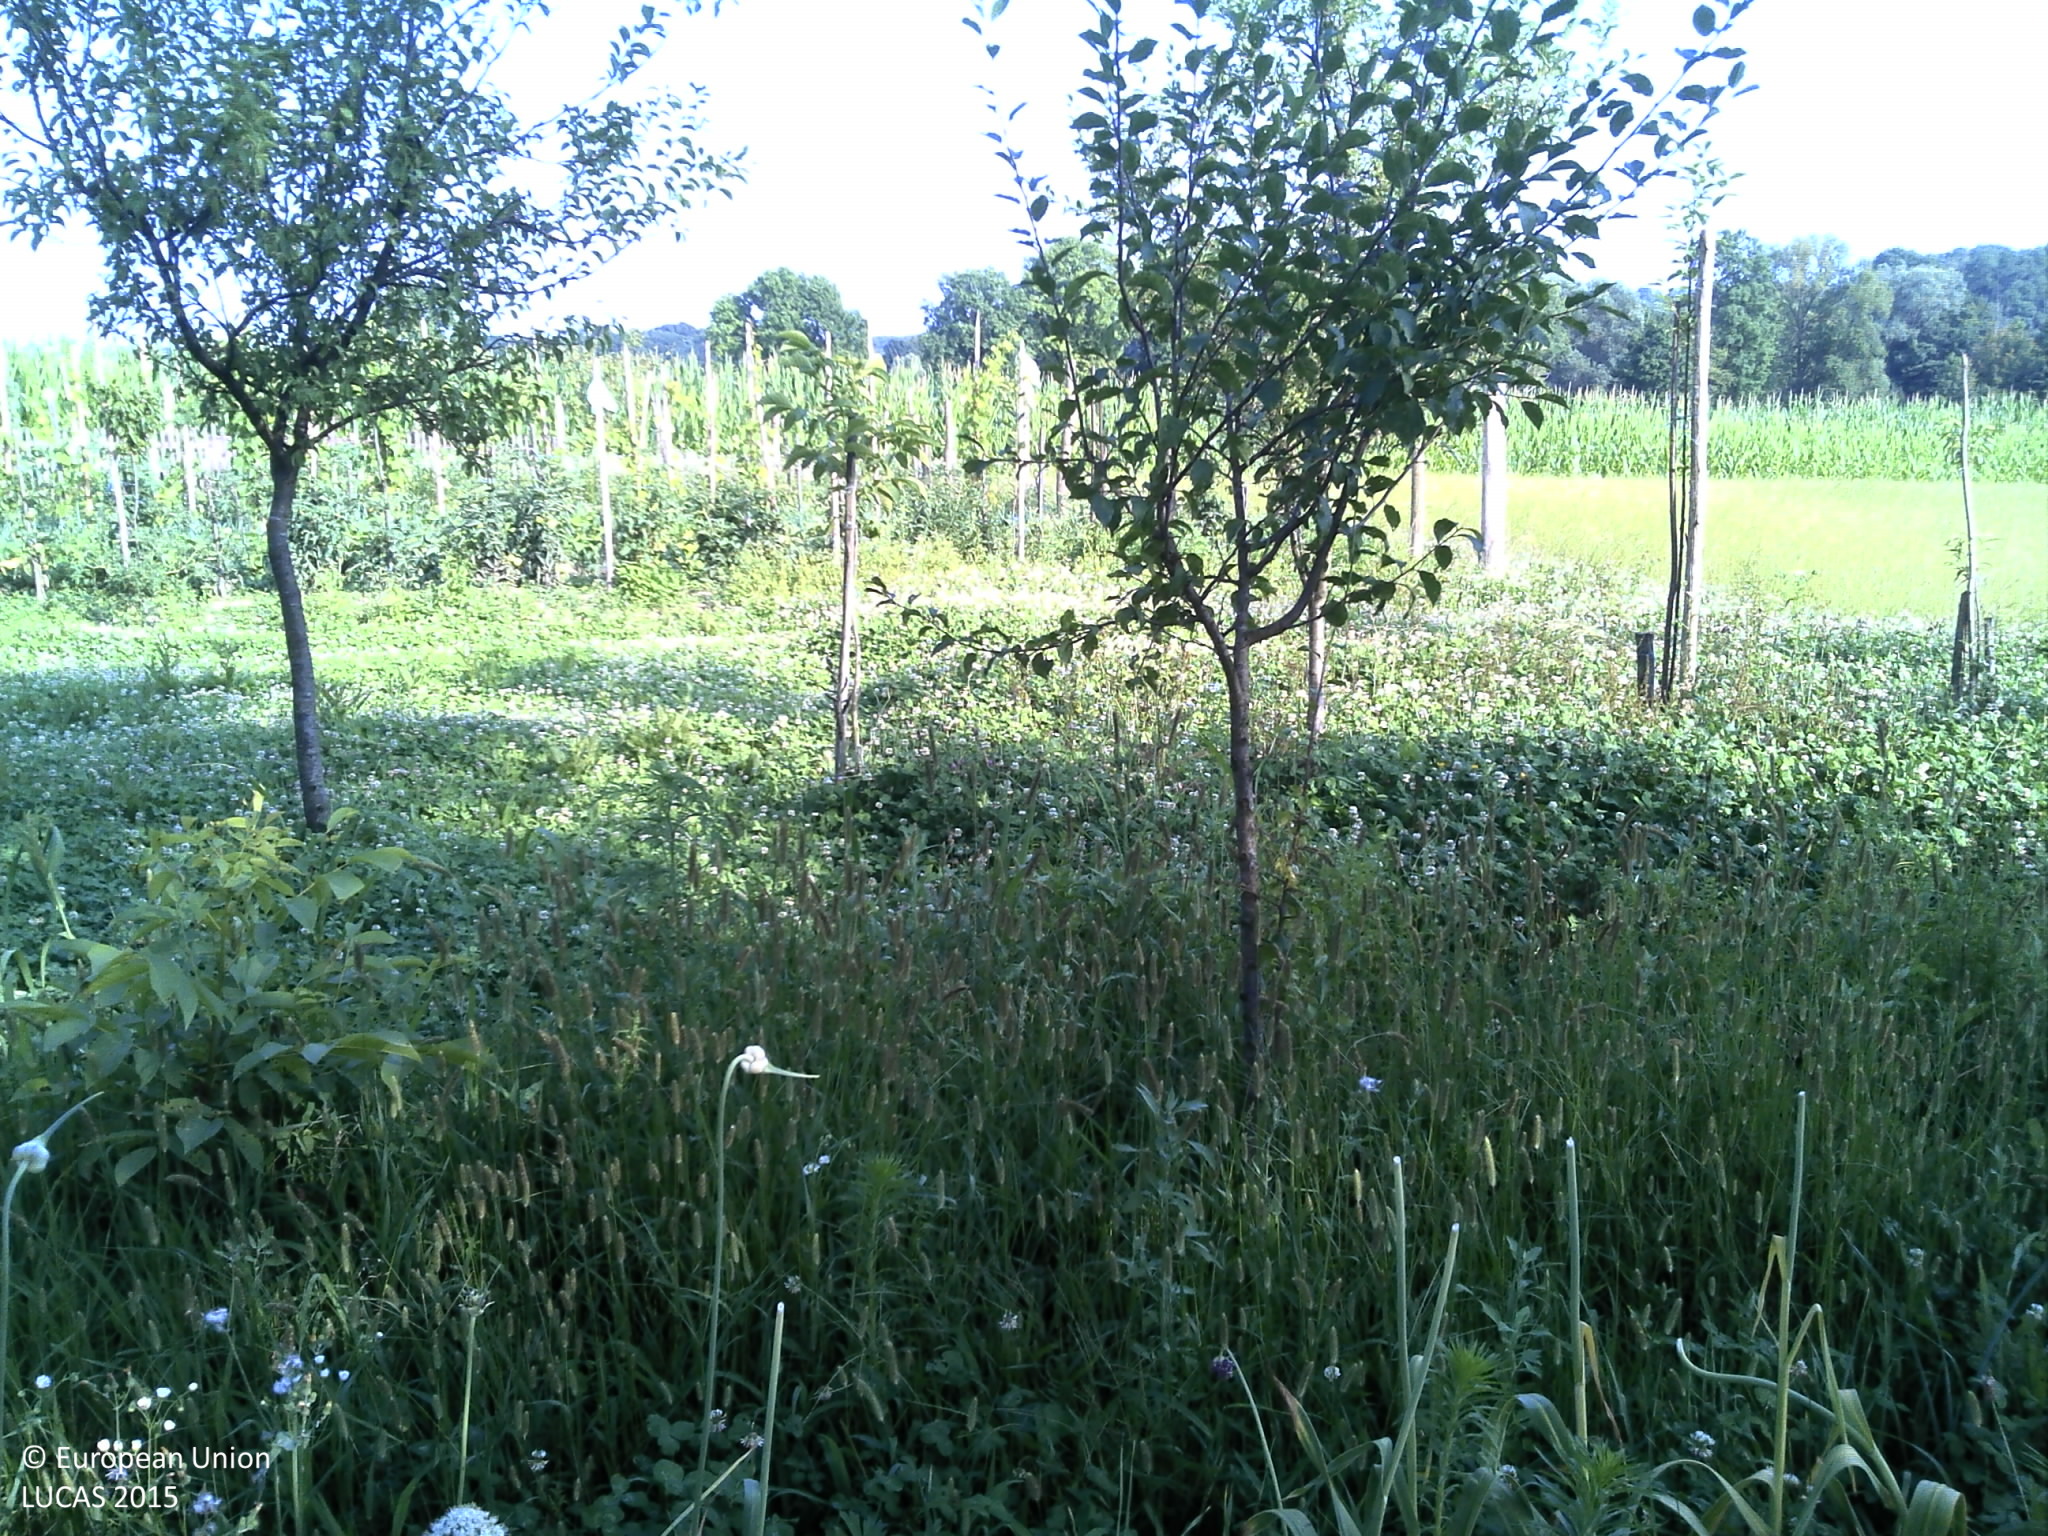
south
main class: Cropland
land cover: Other fresh vegetables
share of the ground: 50 - 75 %
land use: Kitchen garden
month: July
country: HR
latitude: 45.8301
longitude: 16.7583
